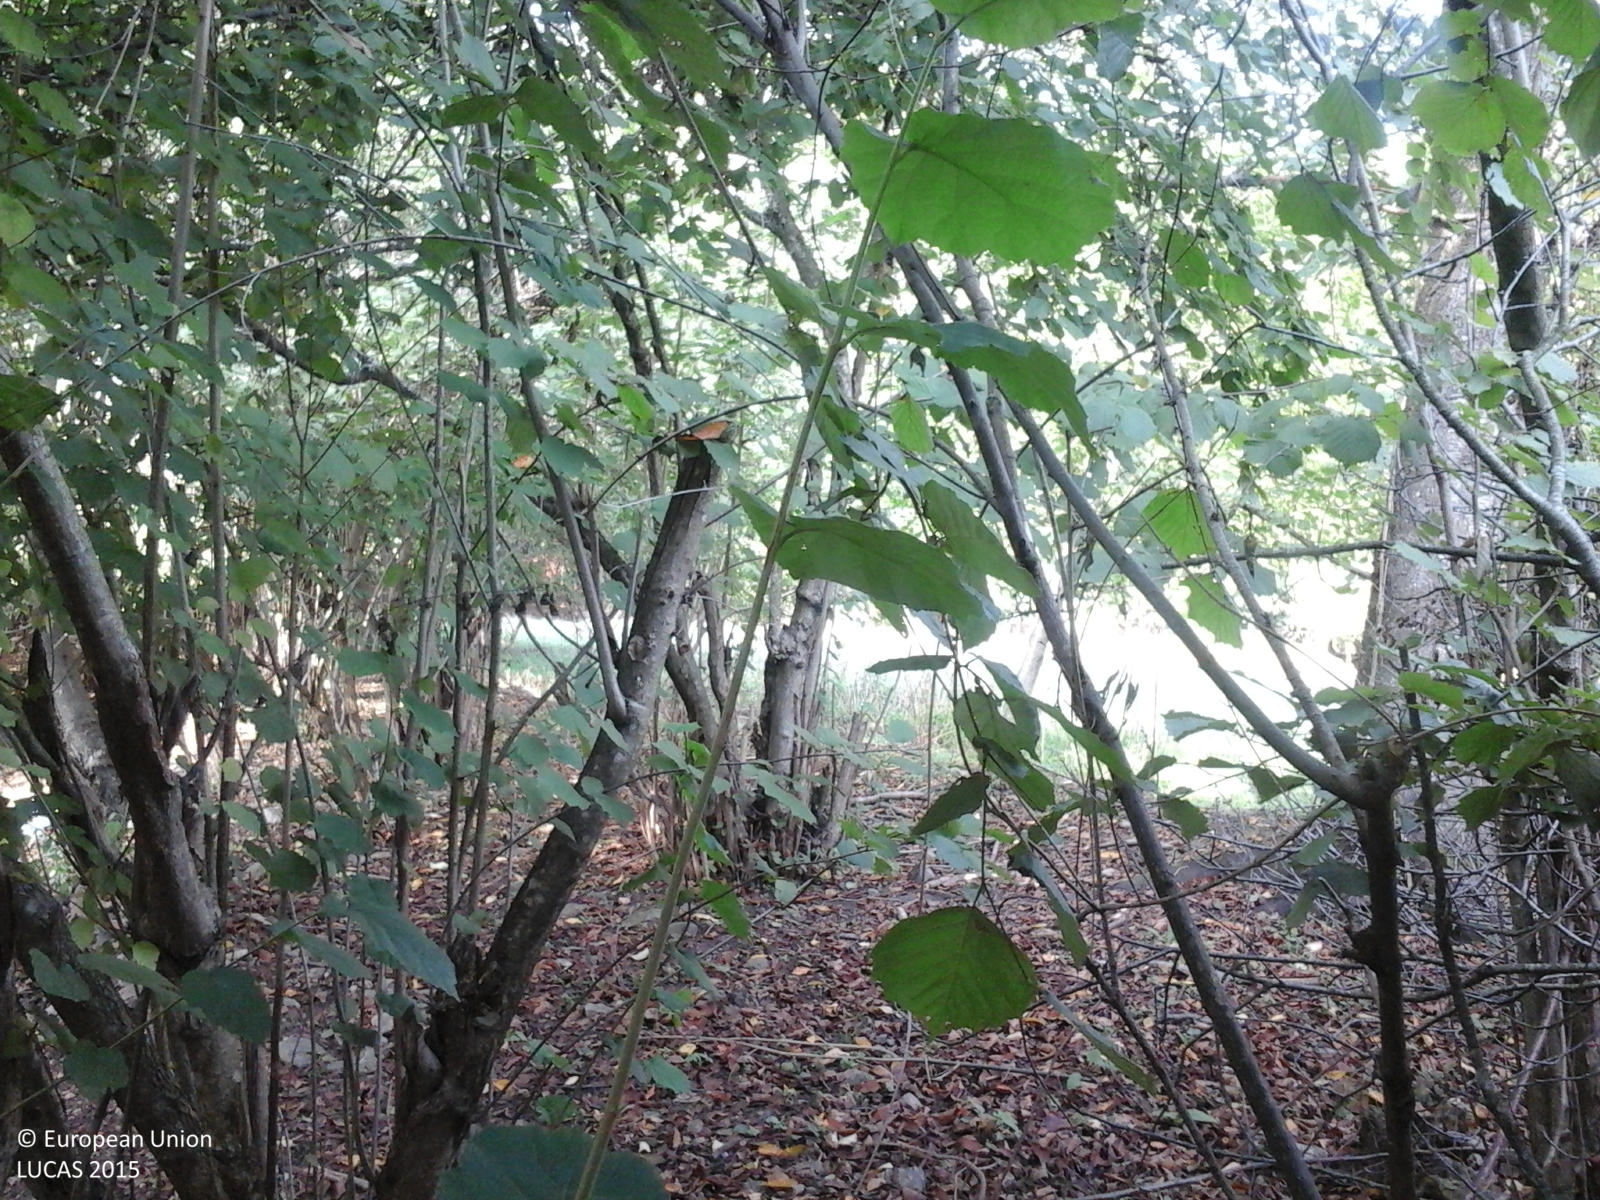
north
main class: Woodland
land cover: Broadleaved woodland
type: mesophytic deciduous forest
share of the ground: > 75 %
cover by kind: broadleaved forest trees 100 %
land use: Forestry
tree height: < 5 m
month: September
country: RO
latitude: 45.5322
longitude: 22.4269
